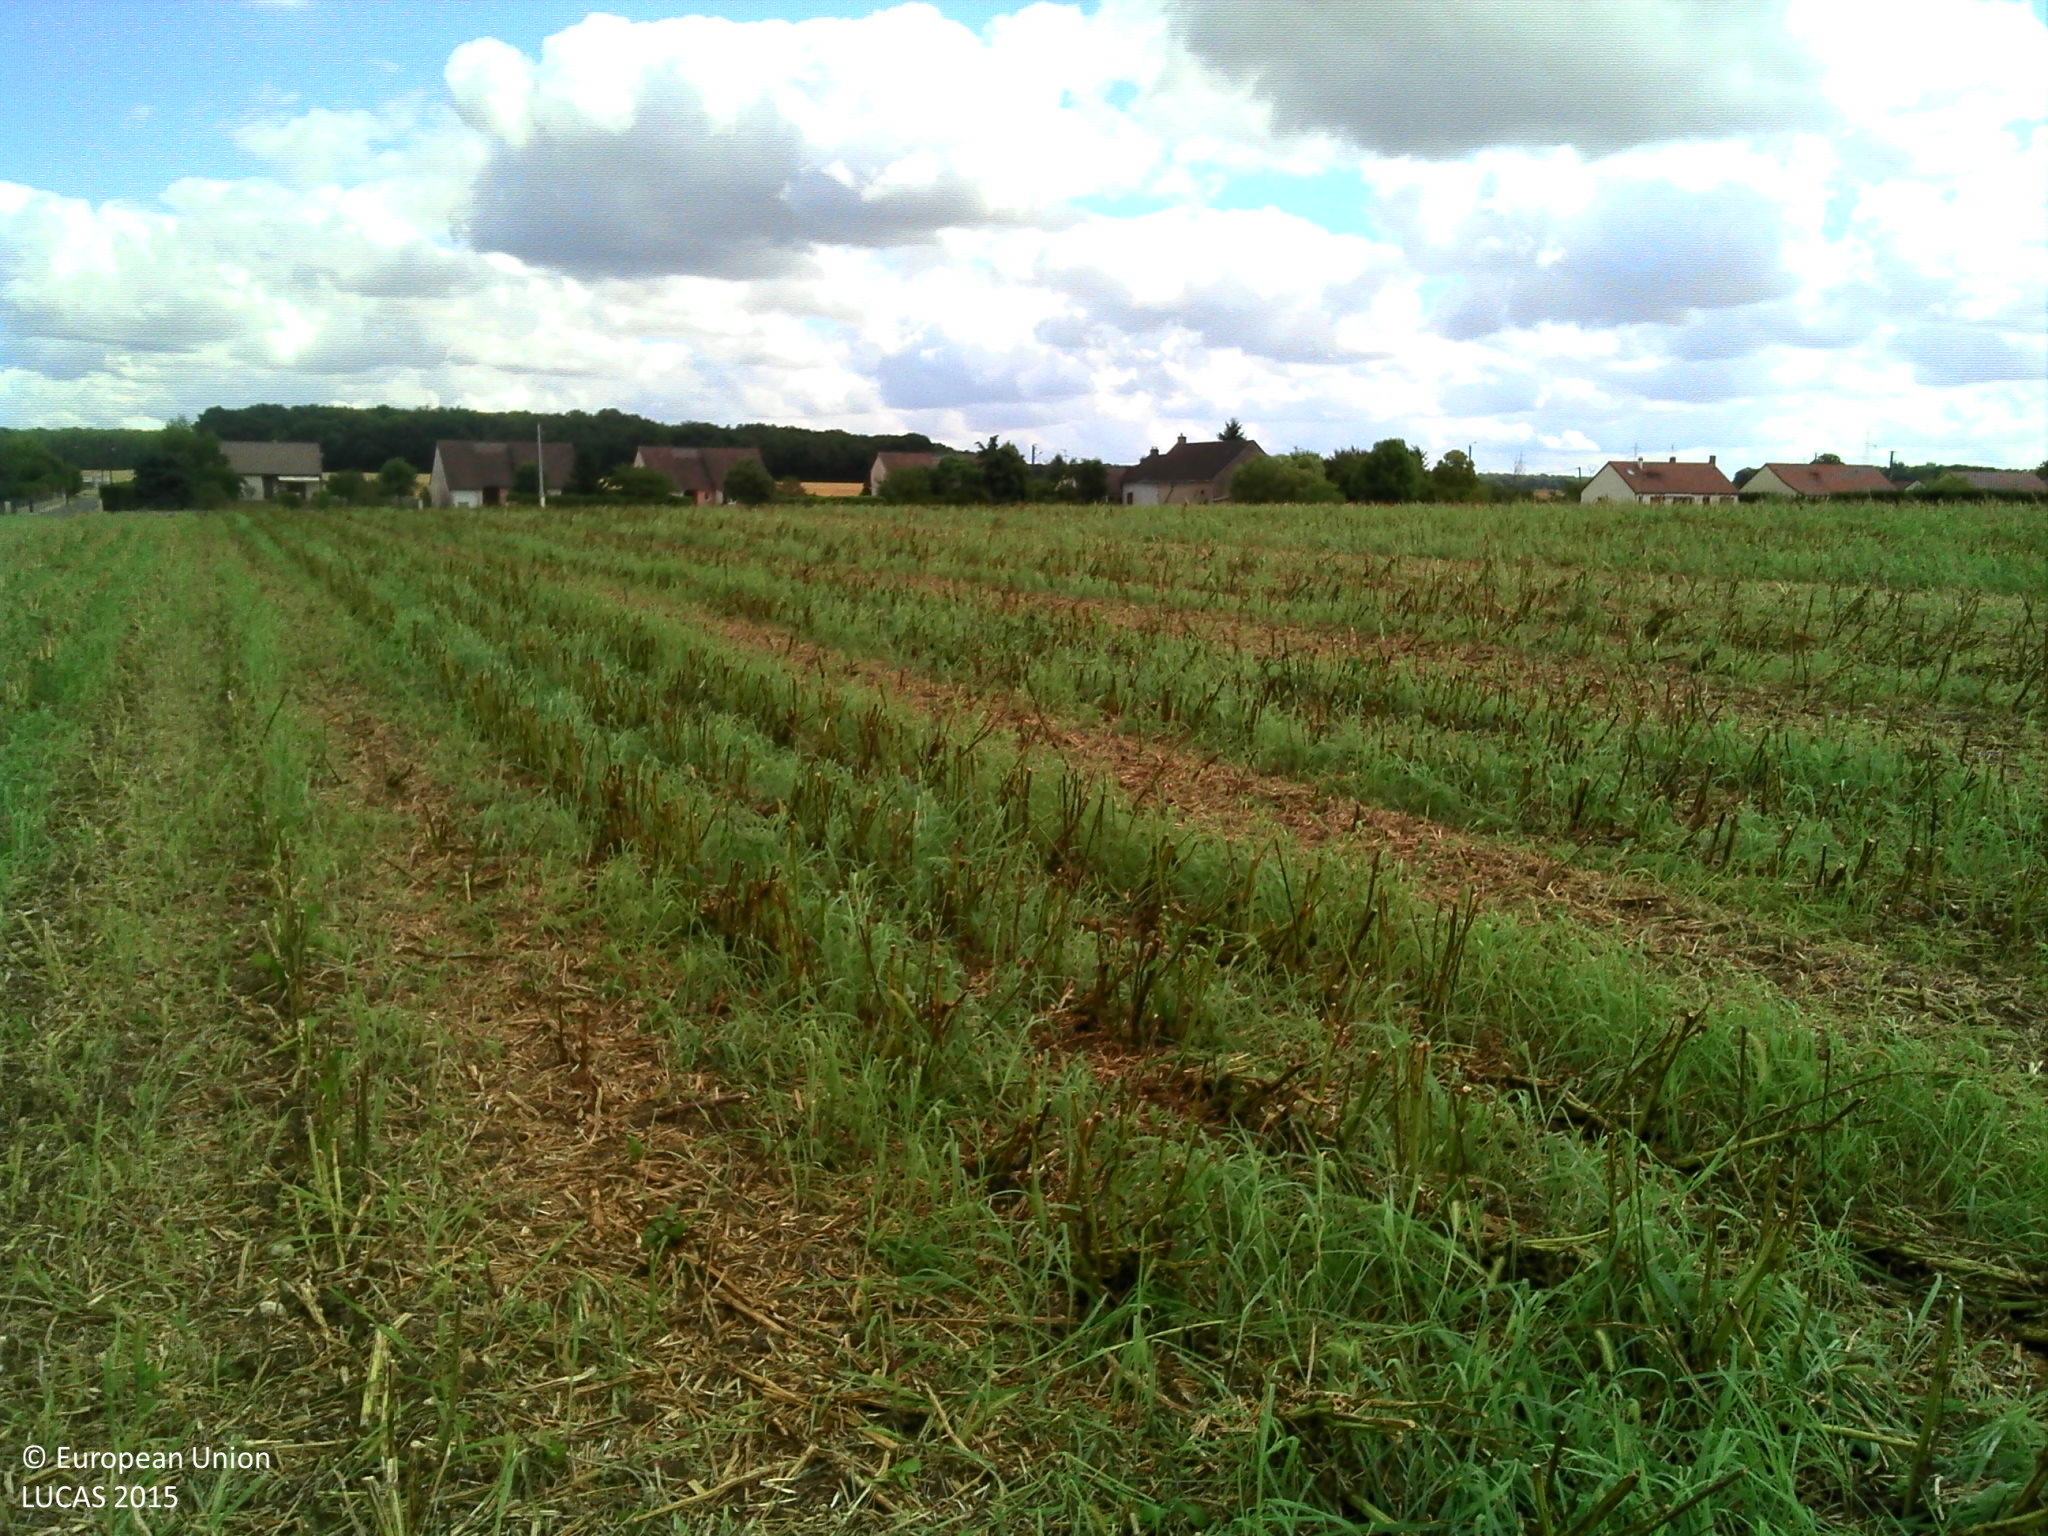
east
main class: Cropland
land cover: Rape and turnip rape
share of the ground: 25 - 50 %
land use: Agriculture (excluding fallow land and kitchen gardens)
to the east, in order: Rape and turnip rape; Artificial constructions in urban areas
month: August
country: FR
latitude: 47.1078
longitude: 2.0977
